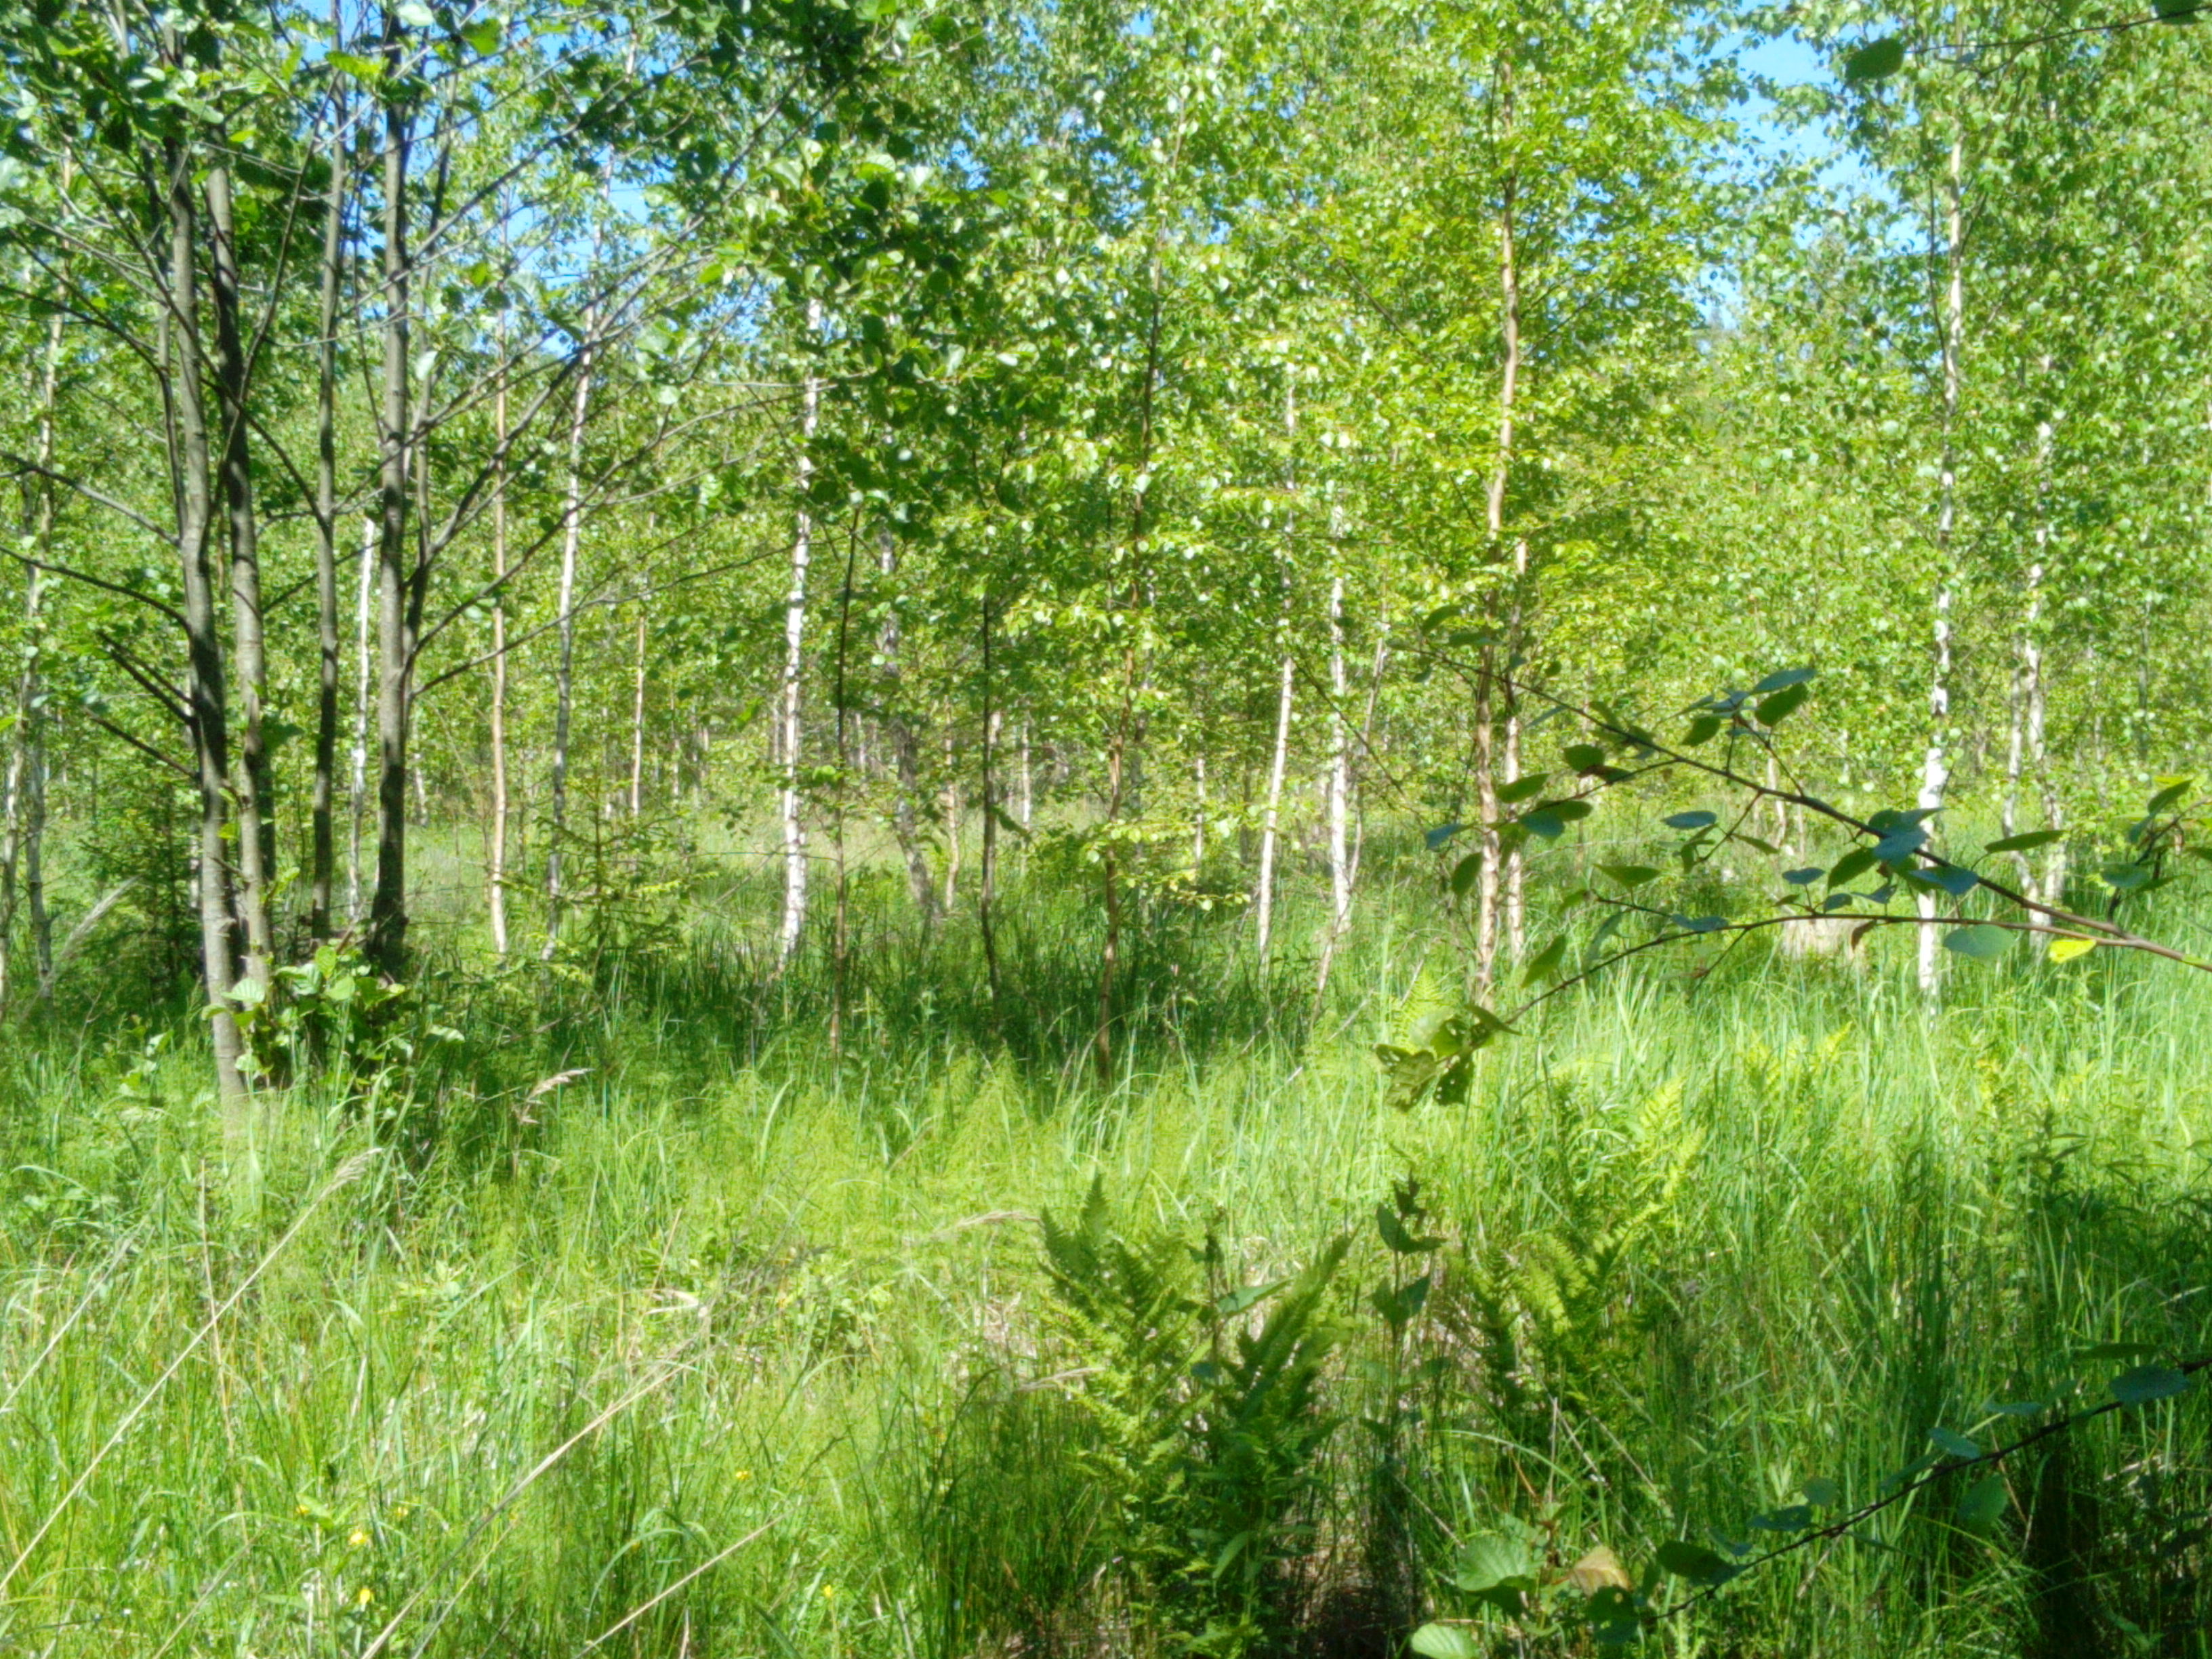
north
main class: Woodland
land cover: Broadleaved woodland
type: non-riverine alder, birch or aspen forest
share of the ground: 50 - 75 %
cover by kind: broadleaved forest trees 45 %, herbaceous plants 40 %, shrubs 10 %, coniferous forest trees 5 %
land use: Forestry
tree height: > 5 m
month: June
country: LV
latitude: 56.6379
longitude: 22.2319
